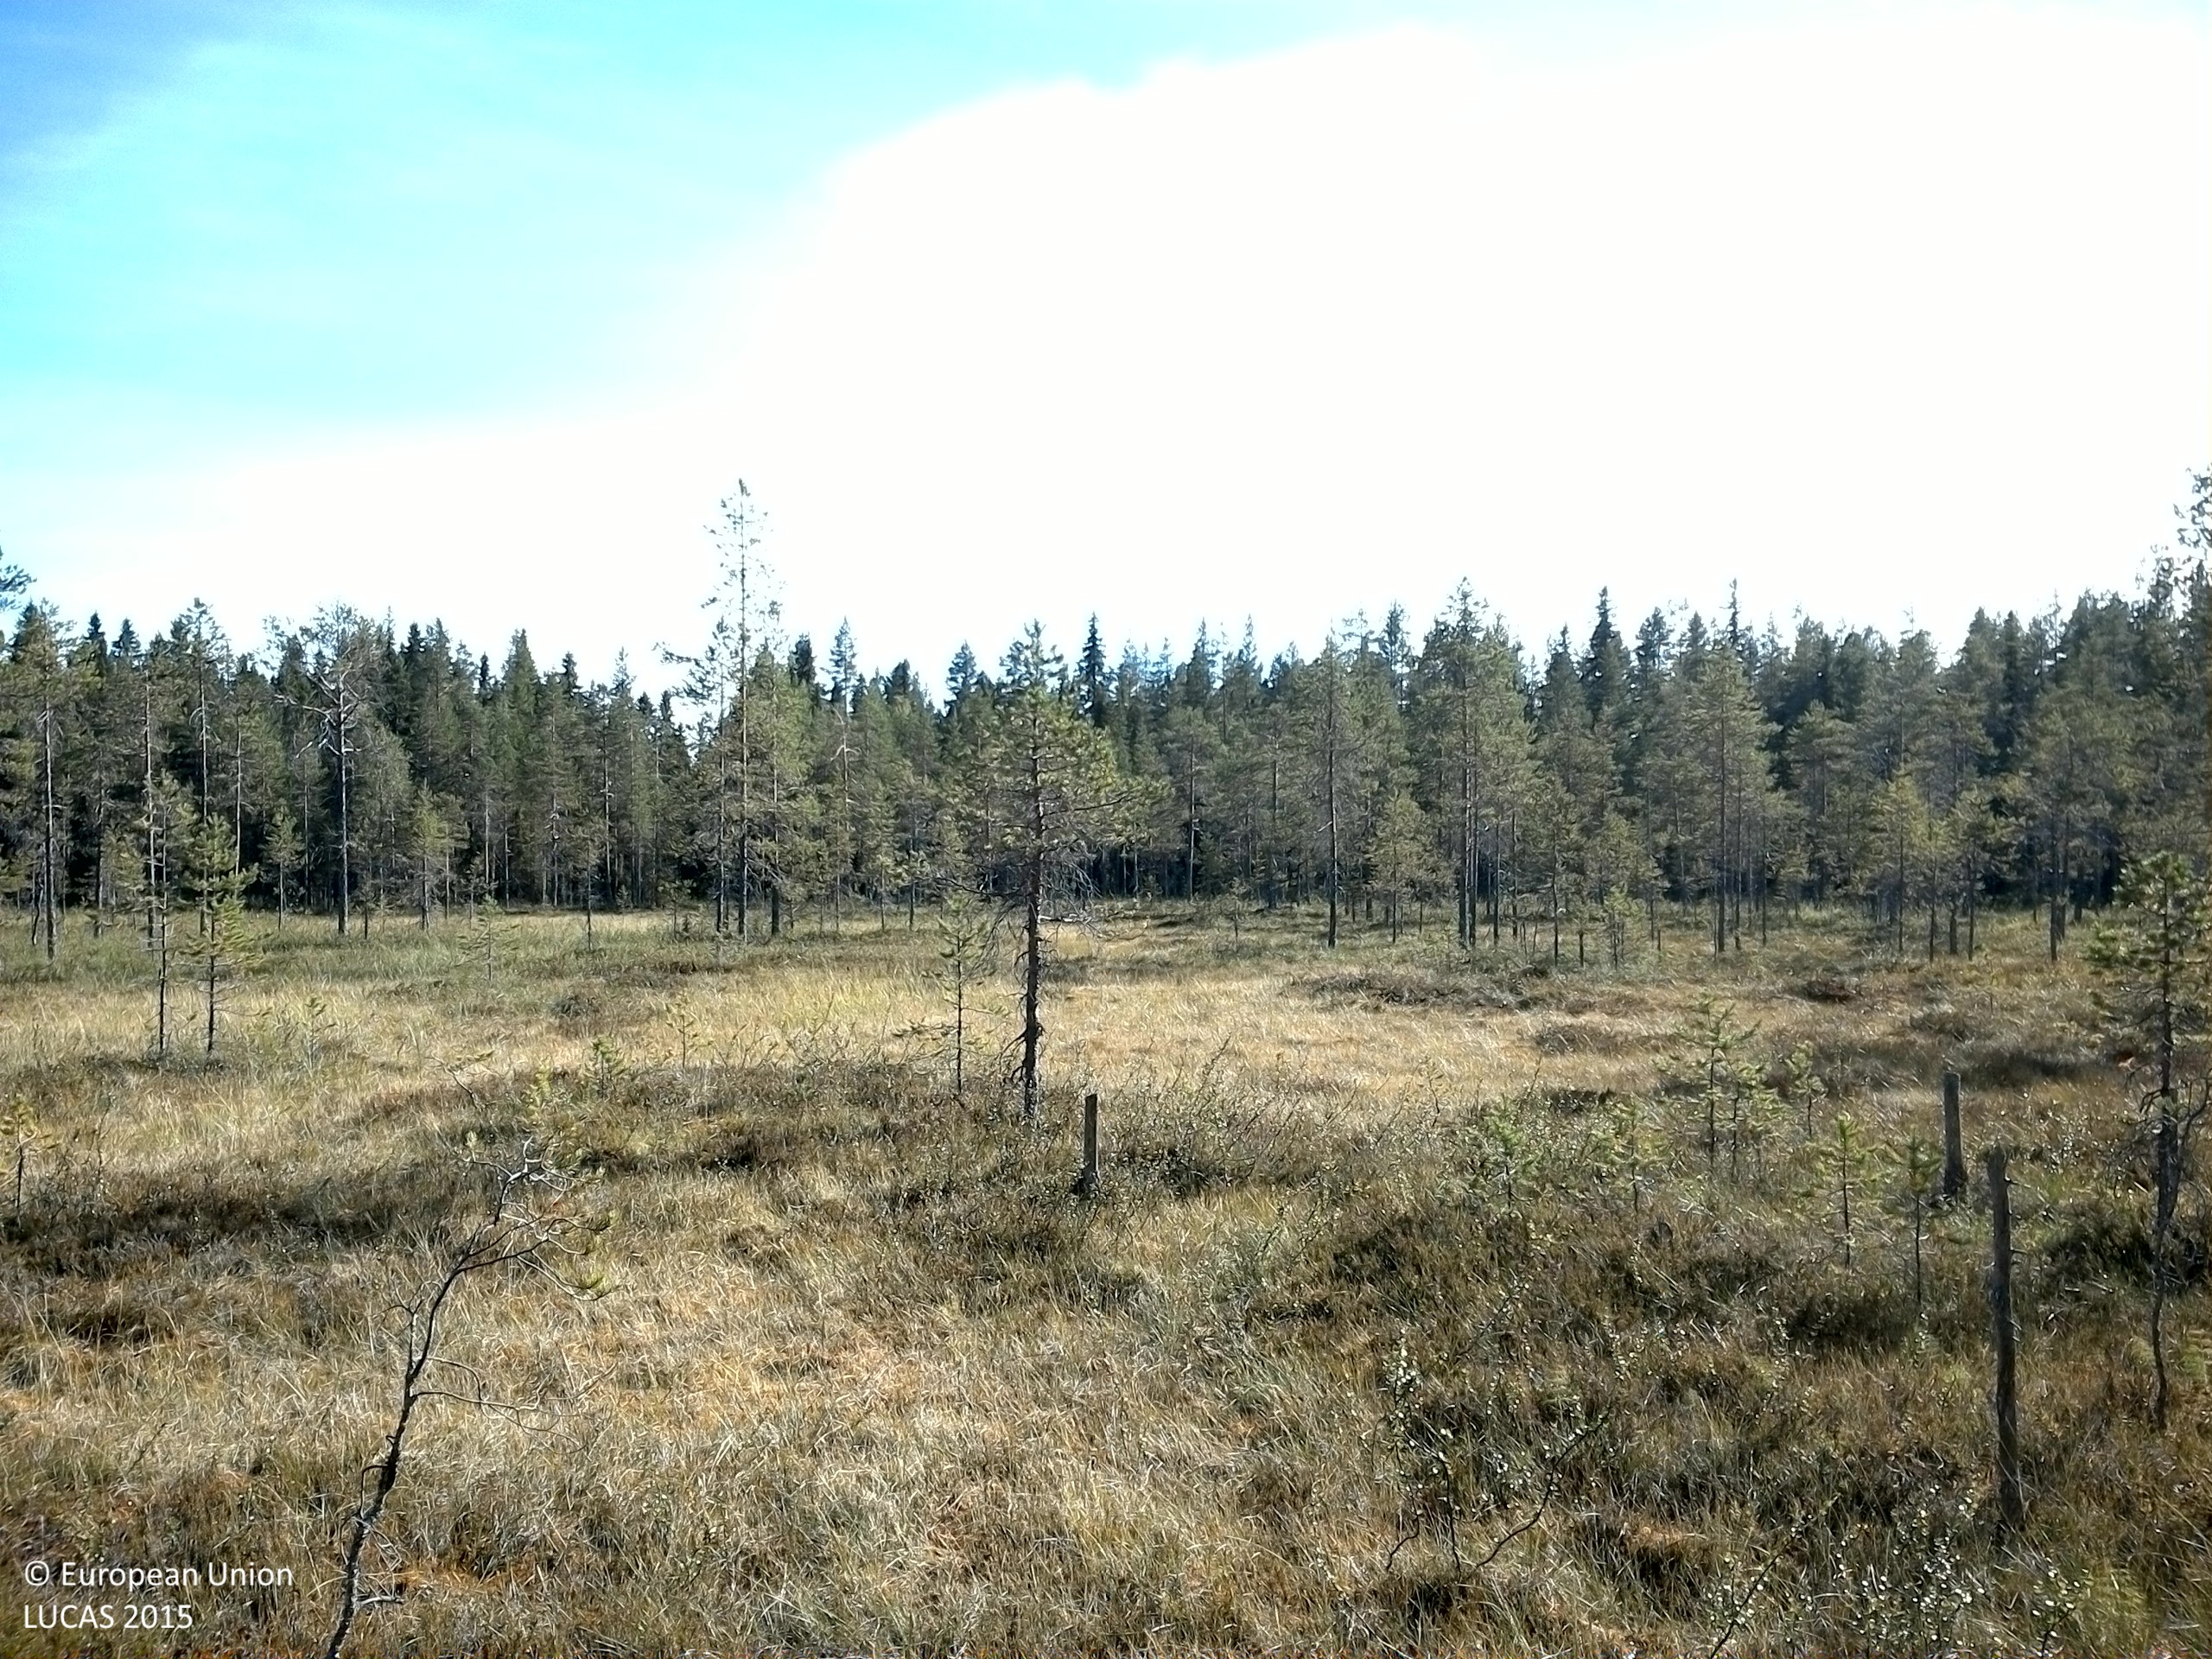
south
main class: Woodland
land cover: Pine dominated coniferous woodland
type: boreal forest
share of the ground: 25 - 50 %
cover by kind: shrubs 40 %, coniferous forest trees 30 %, lichens and mosses 30 %
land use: Semi-natural and natural areas not in use
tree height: < 5 m
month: August
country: SE
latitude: 63.6499
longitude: 18.0310
